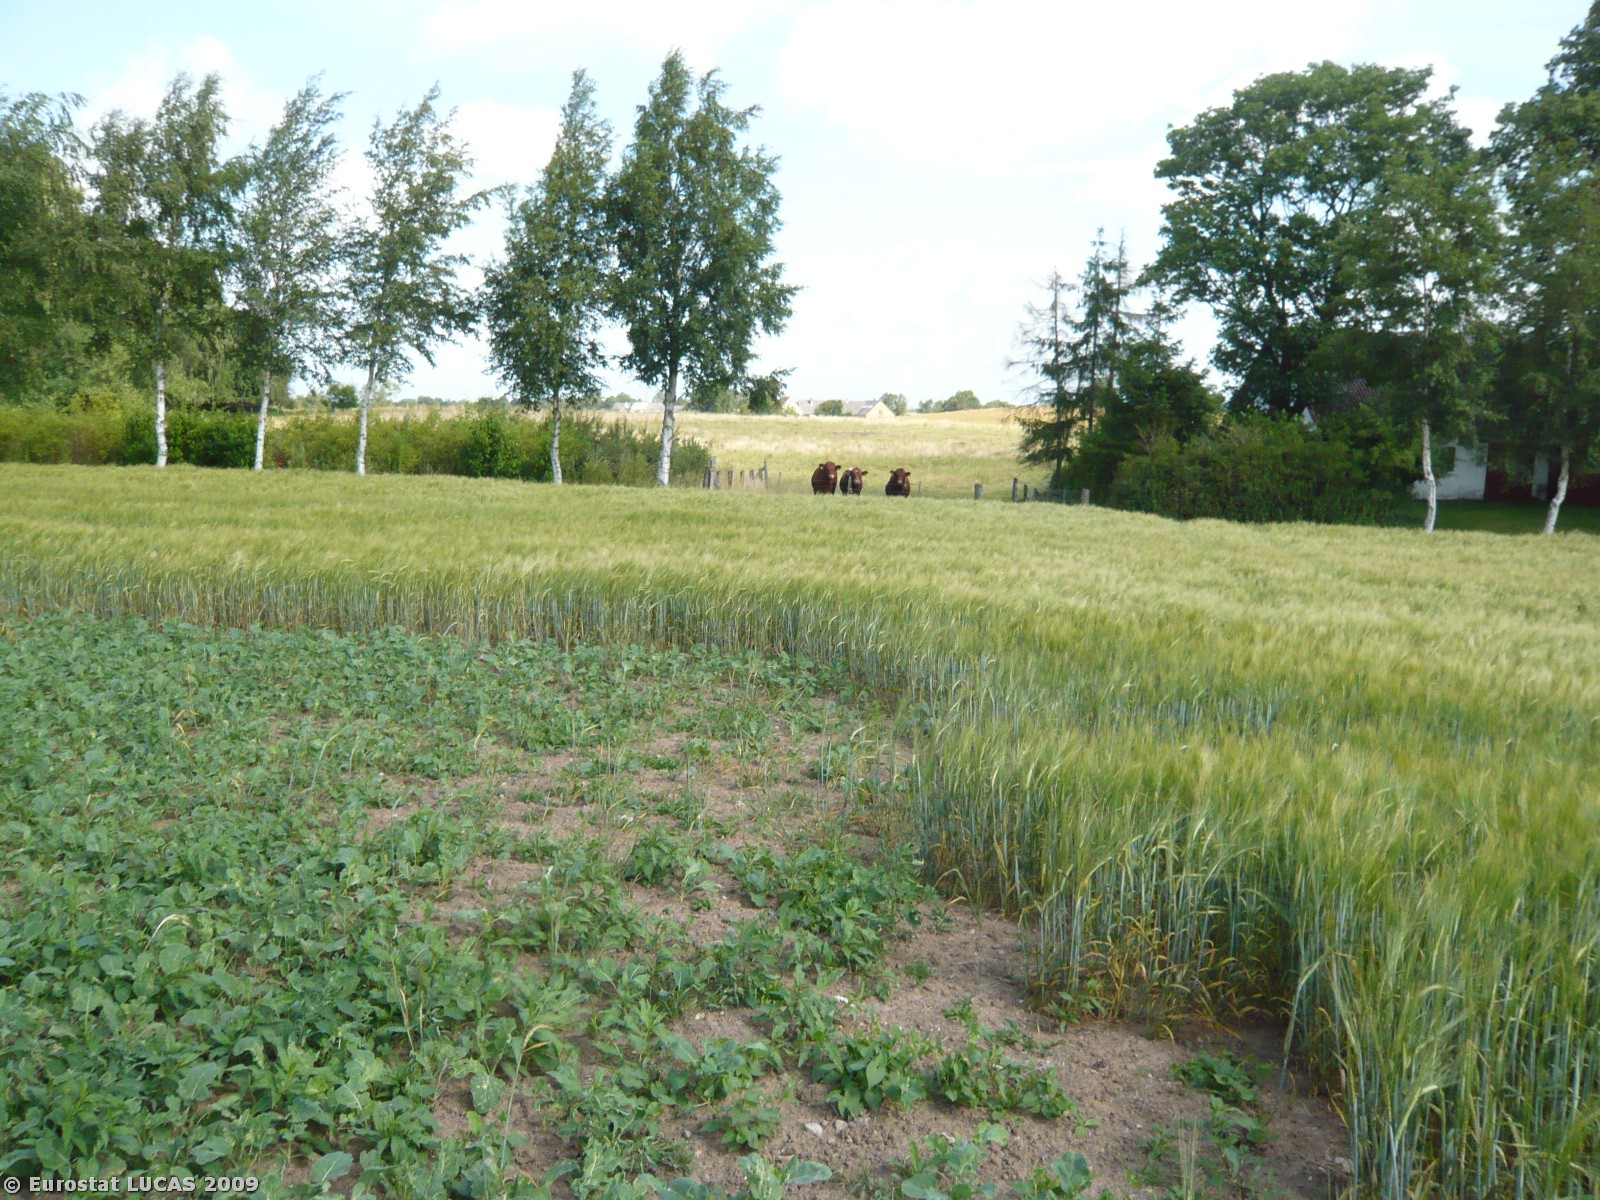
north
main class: Cropland
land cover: Barley
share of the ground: 25 - 50 %
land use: Agriculture (excluding fallow land and kitchen gardens)
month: July
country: DK
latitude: 55.6564
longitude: 11.6038
